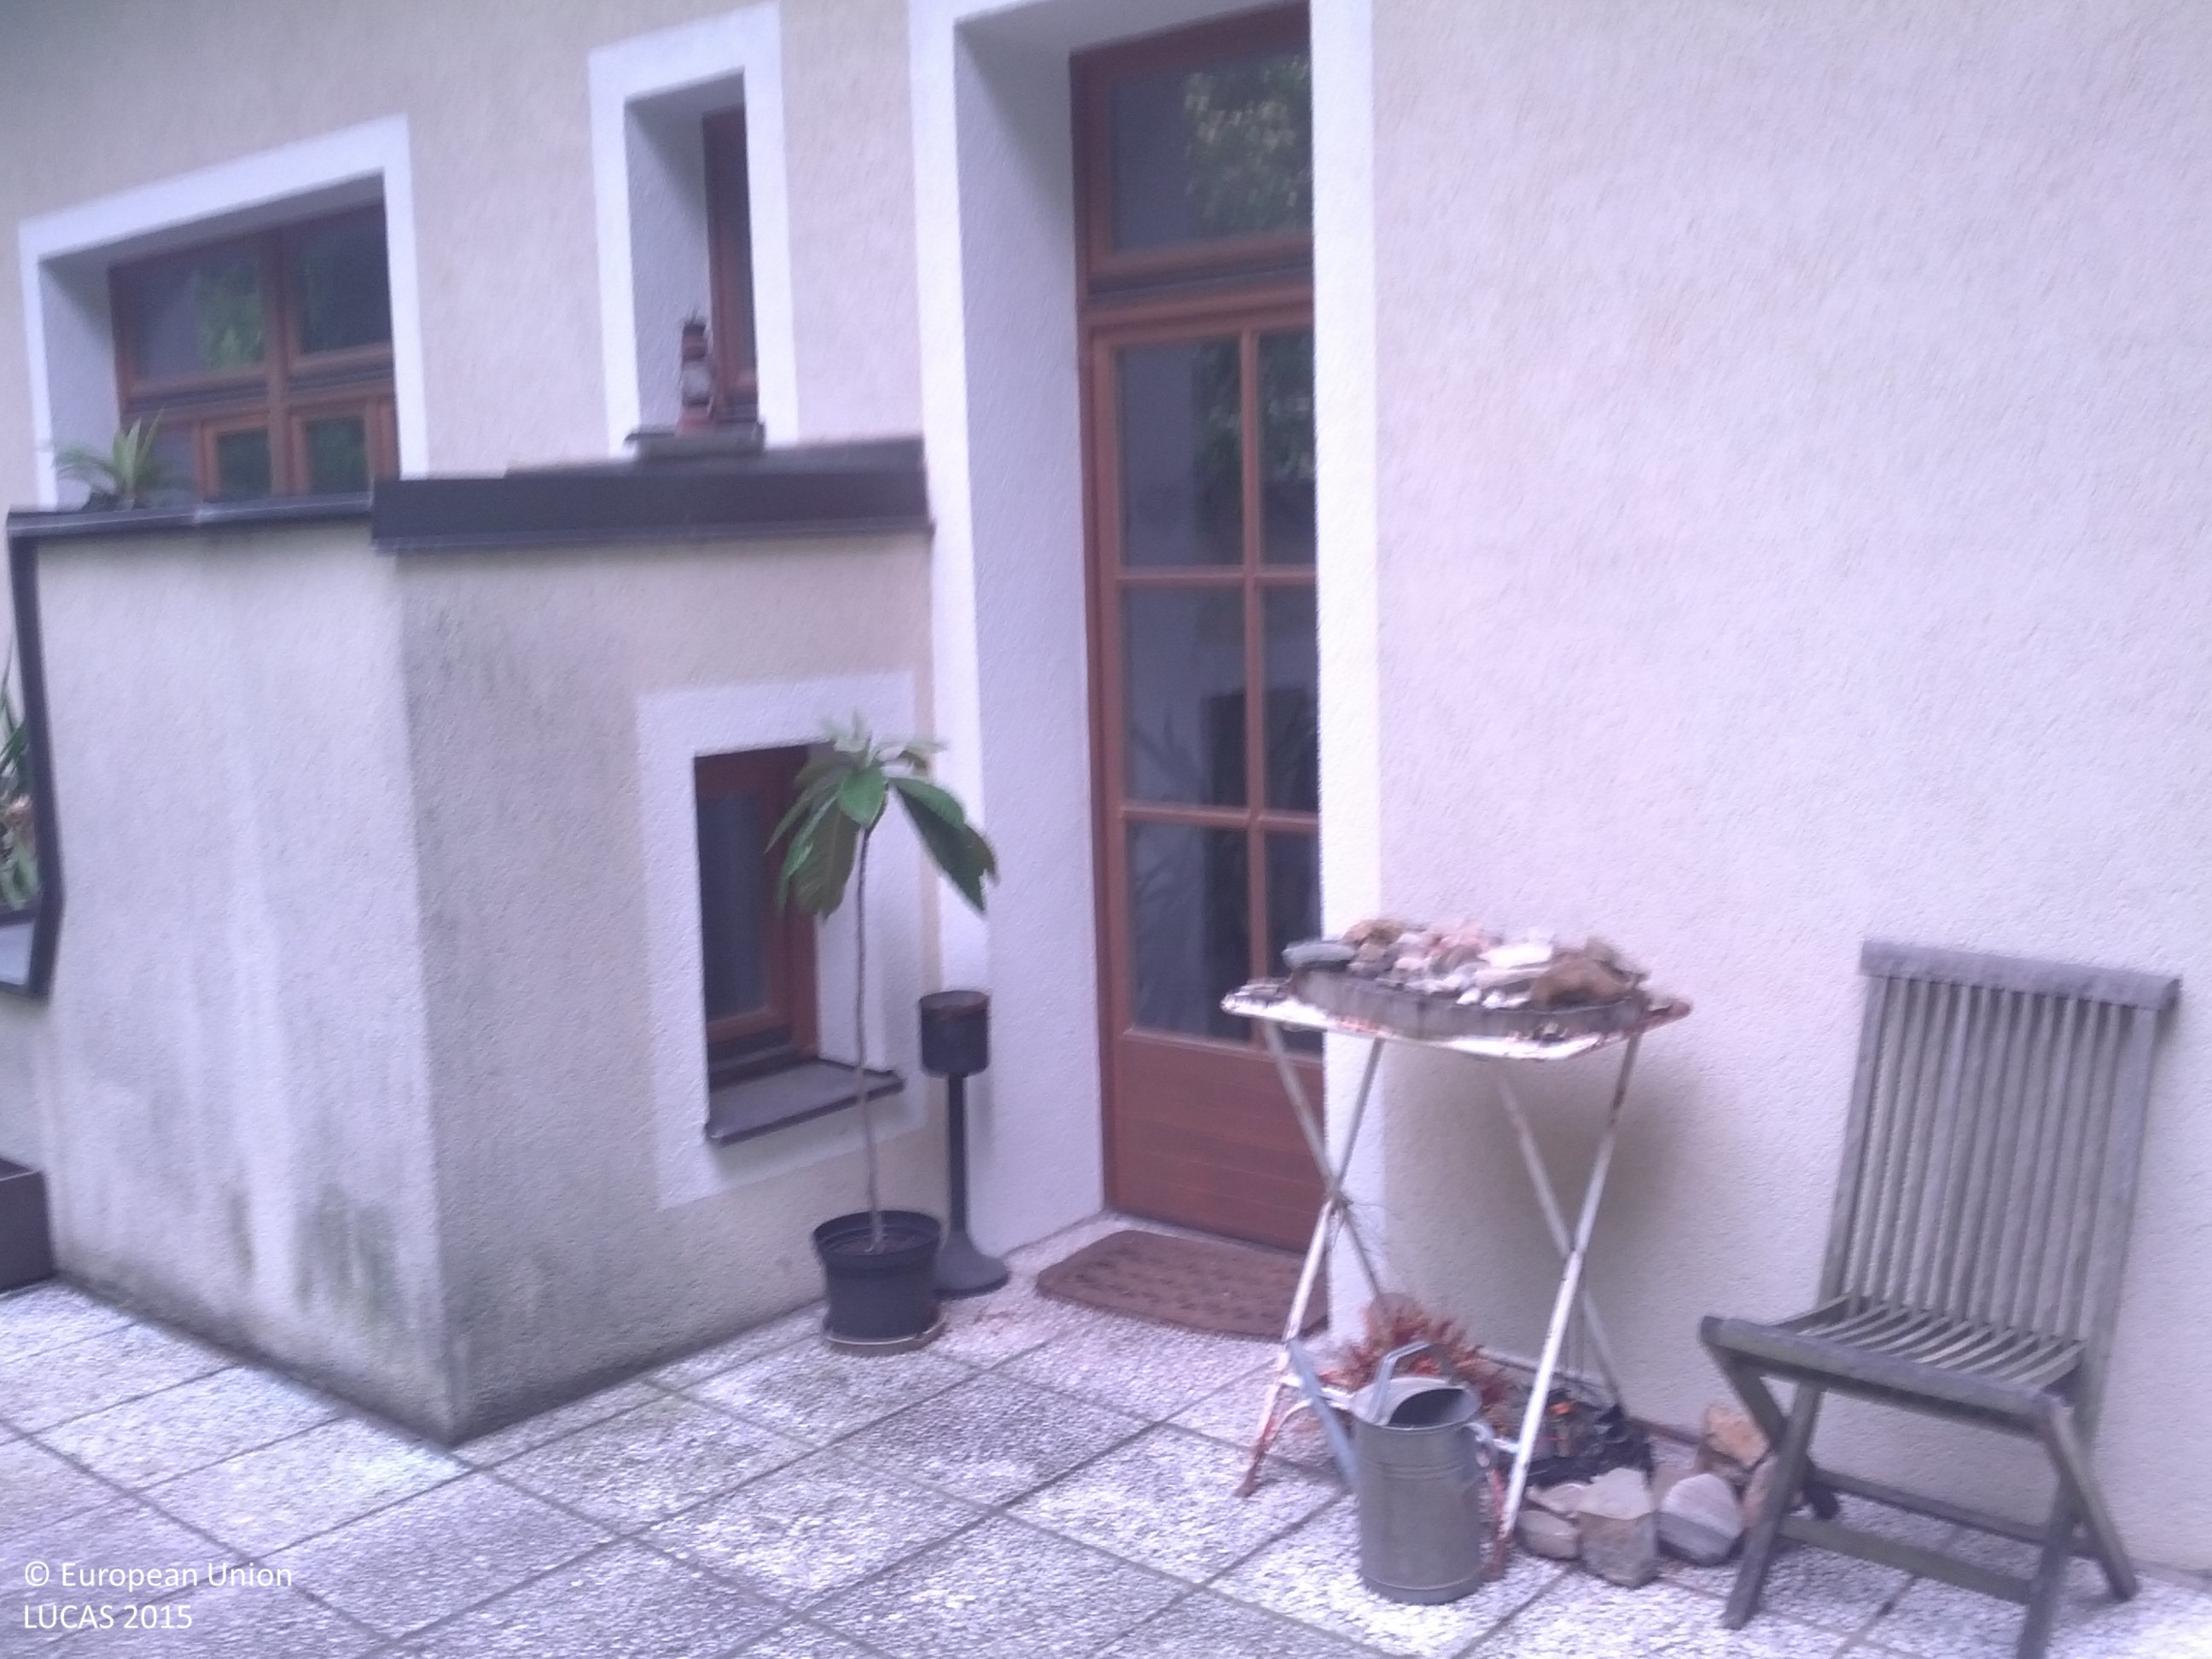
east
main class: Grassland
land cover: Grassland with sparse tree/shrub cover
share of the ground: > 75 %
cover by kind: herbaceous plants 85 %, shrubs 10 %, broadleaved forest trees 5 %
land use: Residential
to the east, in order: Grassland with sparse tree/shrub cover; Artificial constructions in urban areas; Broadleaved woodland; Shrubland with sparse tree cover; Spruce dominated mixed woodland; Artificial constructions in urban areas
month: May
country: AT
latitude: 48.2960
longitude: 16.2999
